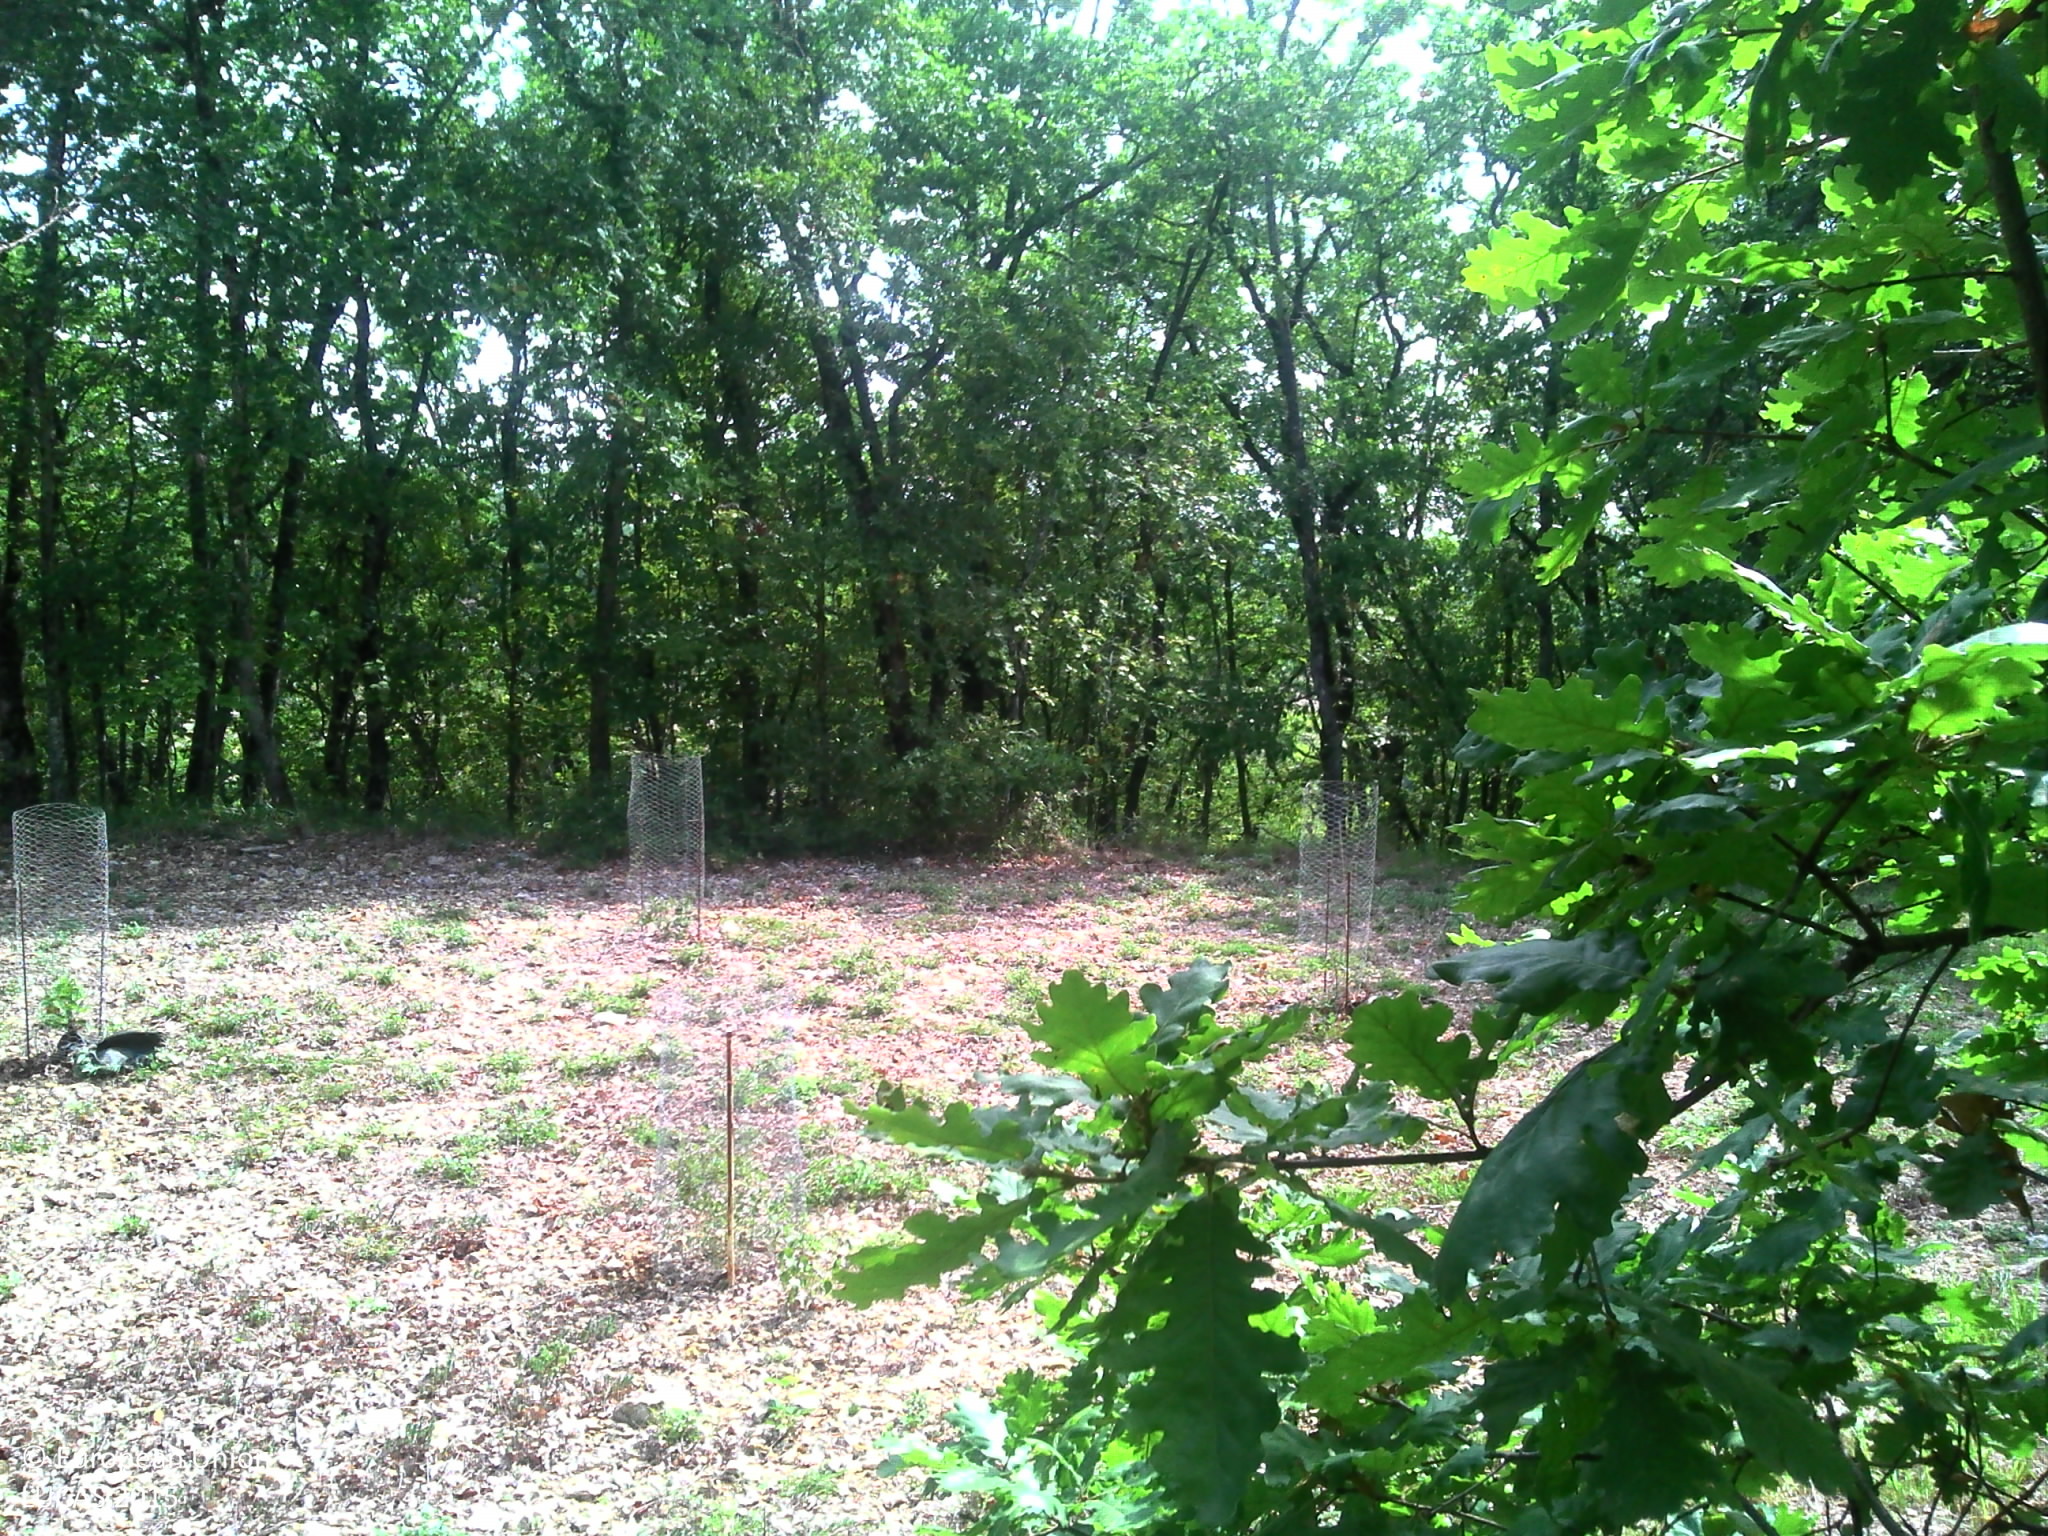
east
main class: Woodland
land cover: Broadleaved woodland
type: thermophilous deciduous forest
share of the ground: > 75 %
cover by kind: broadleaved forest trees 80 %, shrubs 10 %, herbaceous plants 10 %
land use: Forestry
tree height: > 5 m
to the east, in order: Broadleaved woodland; Other bare soil; Broadleaved woodland; Grass margins; Other bare soil; Grass margins; Fences; Broadleaved woodland; Shrubland without tree cover; Grassland without tree/shrub cover; Broadleaved woodland; Grassland without tree/shrub cover; Shrubland without tree cover; Fences; Broadleaved woodland; Other bare soil; Inland fresh water bodies
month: August
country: FR
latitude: 44.3571
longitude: 1.2023
